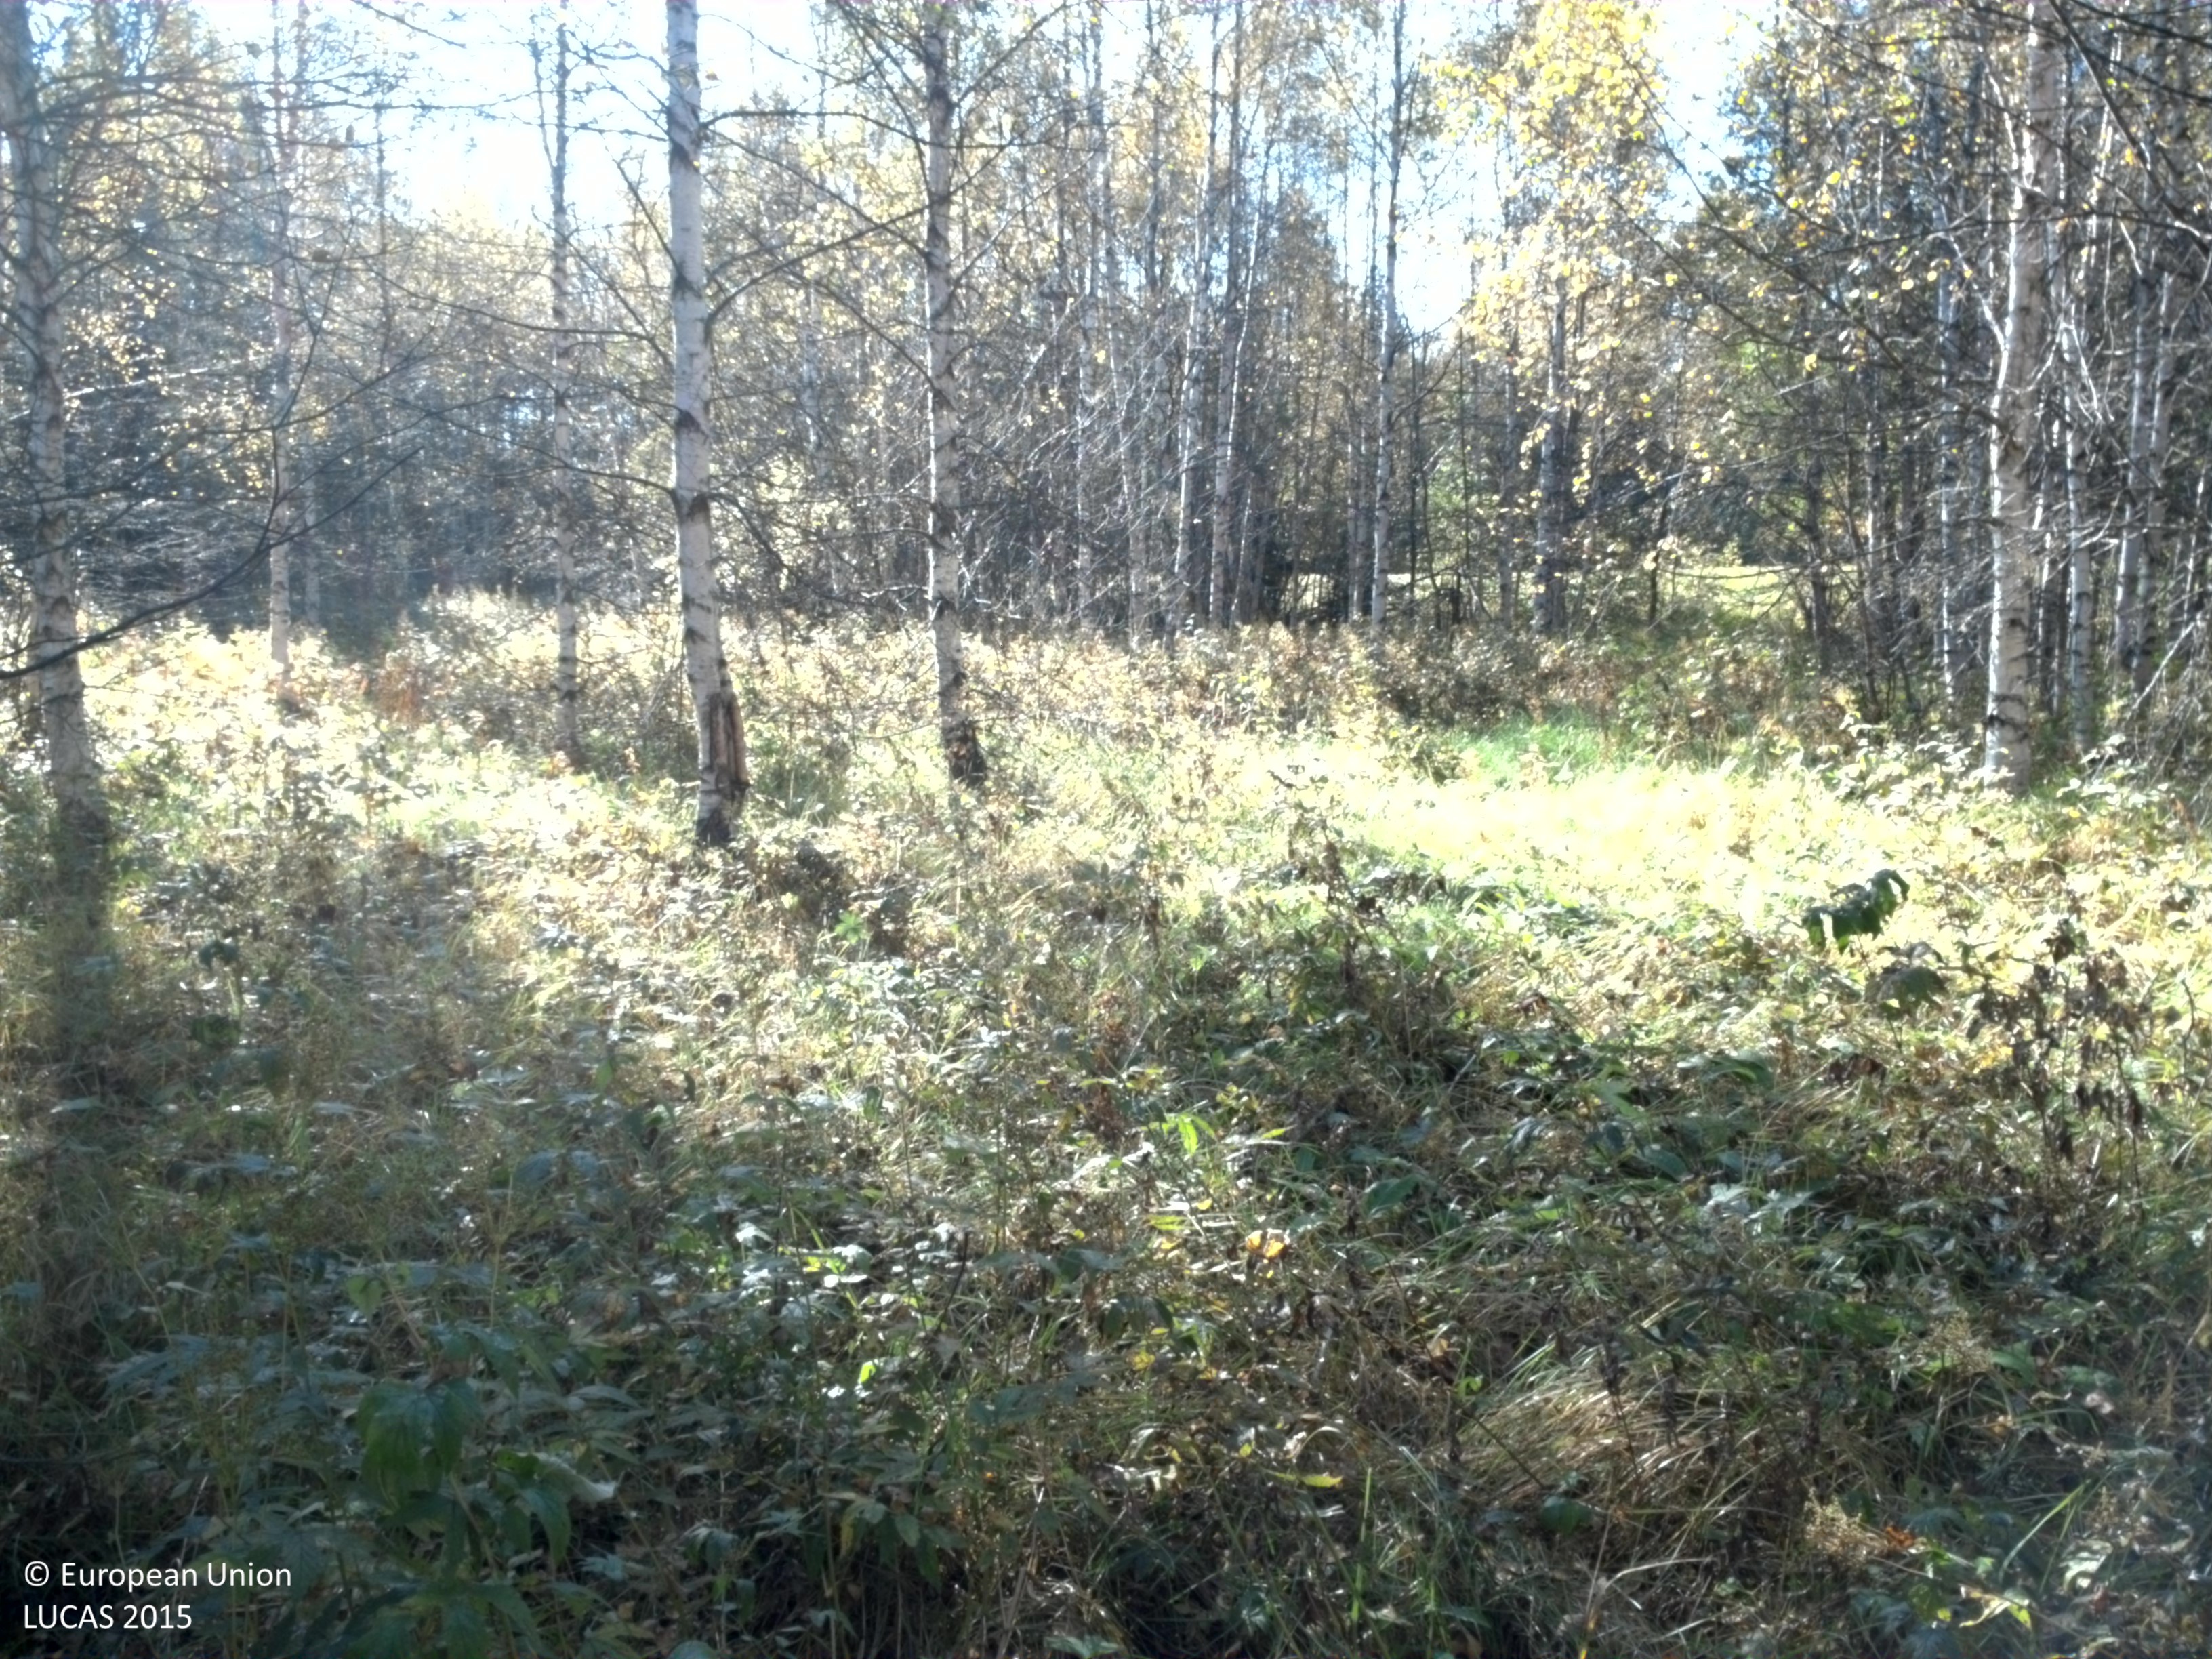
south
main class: Woodland
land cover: Broadleaved woodland
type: floodplain forest
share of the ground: 25 - 50 %
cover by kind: shrubs 40 %, broadleaved forest trees 30 %, herbaceous plants 30 %
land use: Forestry
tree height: > 5 m
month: September
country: SE
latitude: 65.8878
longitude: 22.1952
